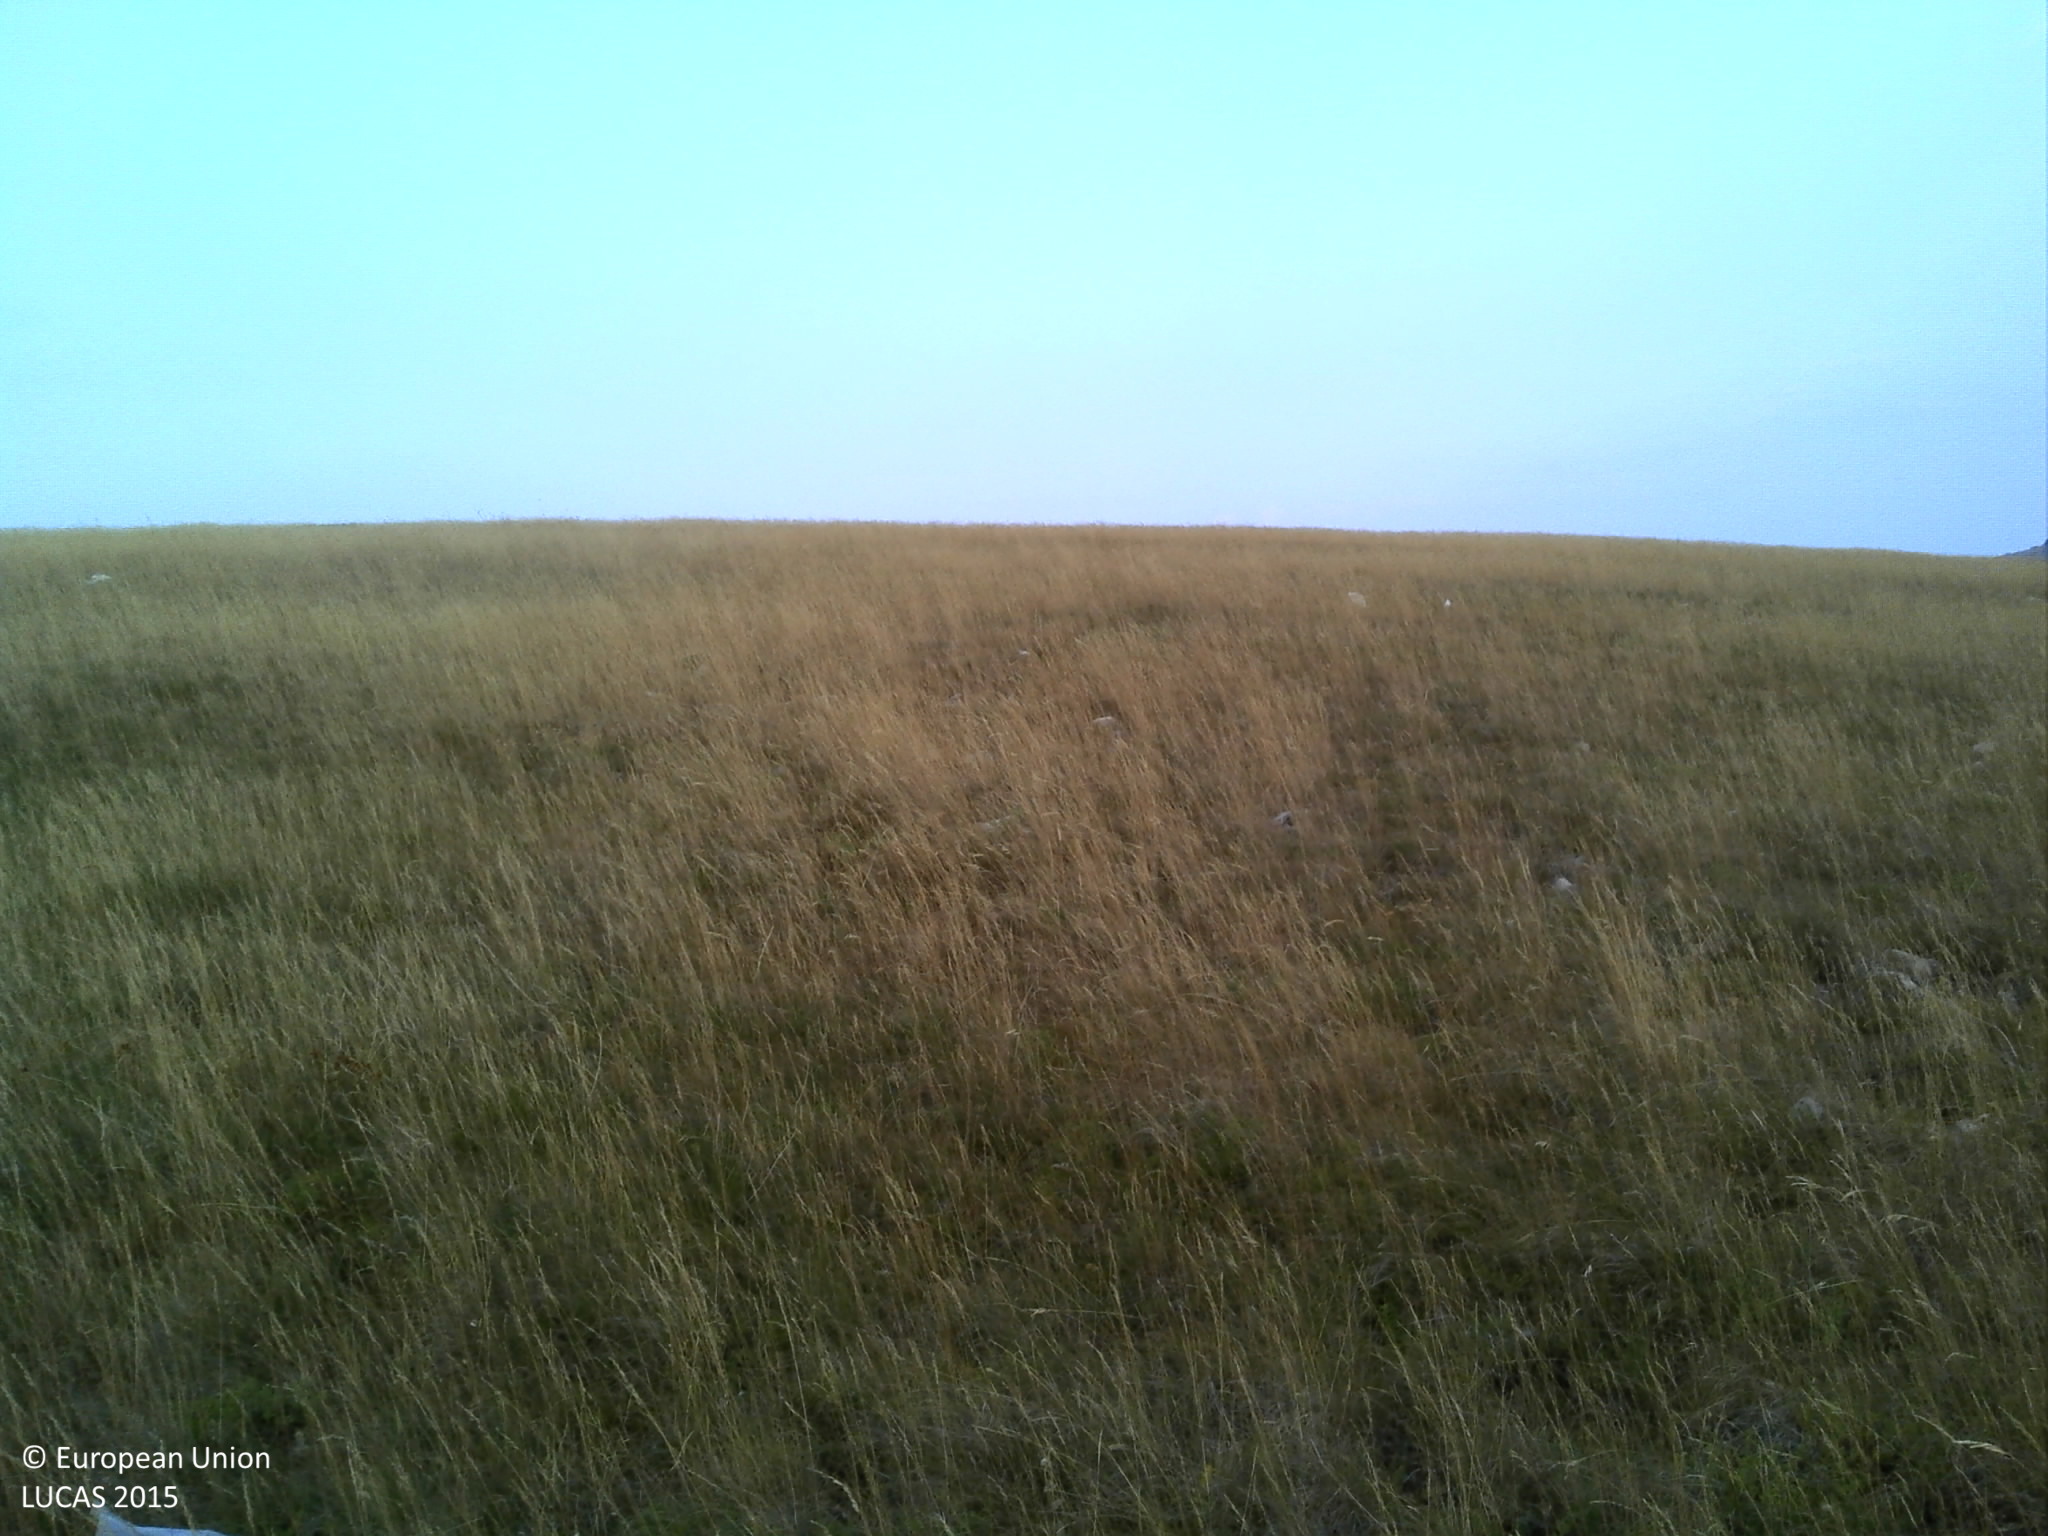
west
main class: Grassland
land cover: Grassland without tree/shrub cover
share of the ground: > 75 %
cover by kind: herbaceous plants 95 %, shrubs 5 %
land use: Abandoned areas
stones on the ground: < 10 %
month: July
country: HR
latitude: 44.2289
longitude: 16.0397
